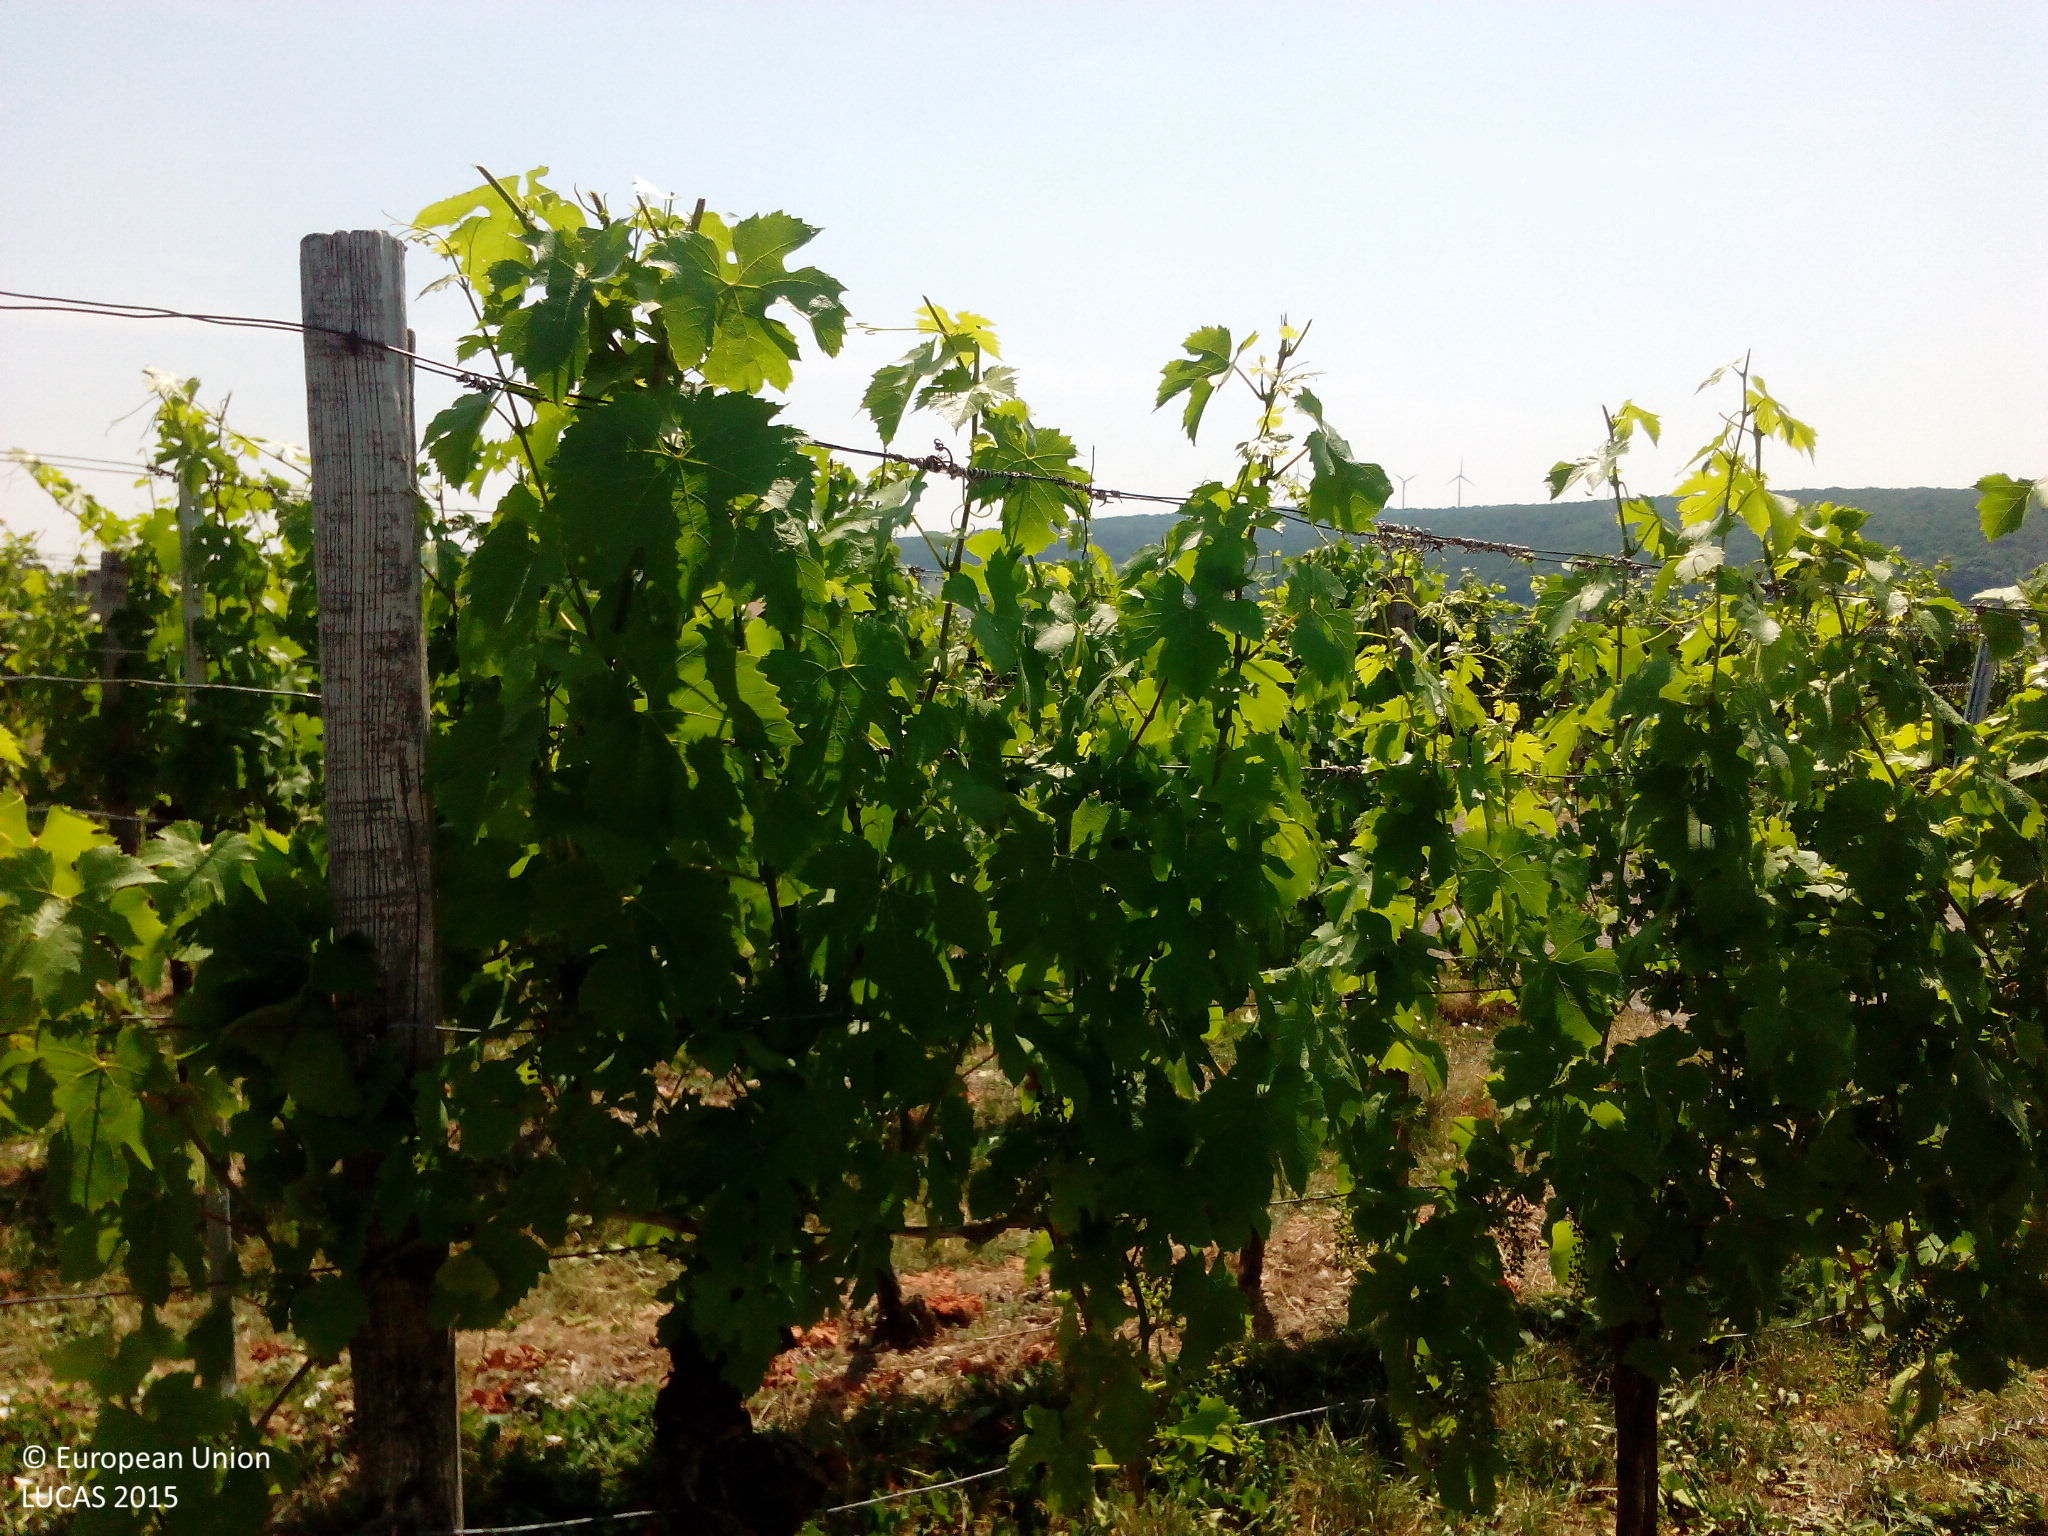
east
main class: Cropland
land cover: Vineyards
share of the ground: 25 - 50 %
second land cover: Spontaneously vegetated surfaces
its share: > 75 %
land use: Agriculture (excluding fallow land and kitchen gardens)
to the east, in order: Vineyards; Spontaneously vegetated surfaces; Paved roads, cycling and walking lanes; Vineyards
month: July
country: DE
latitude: 49.5008
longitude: 9.9310
